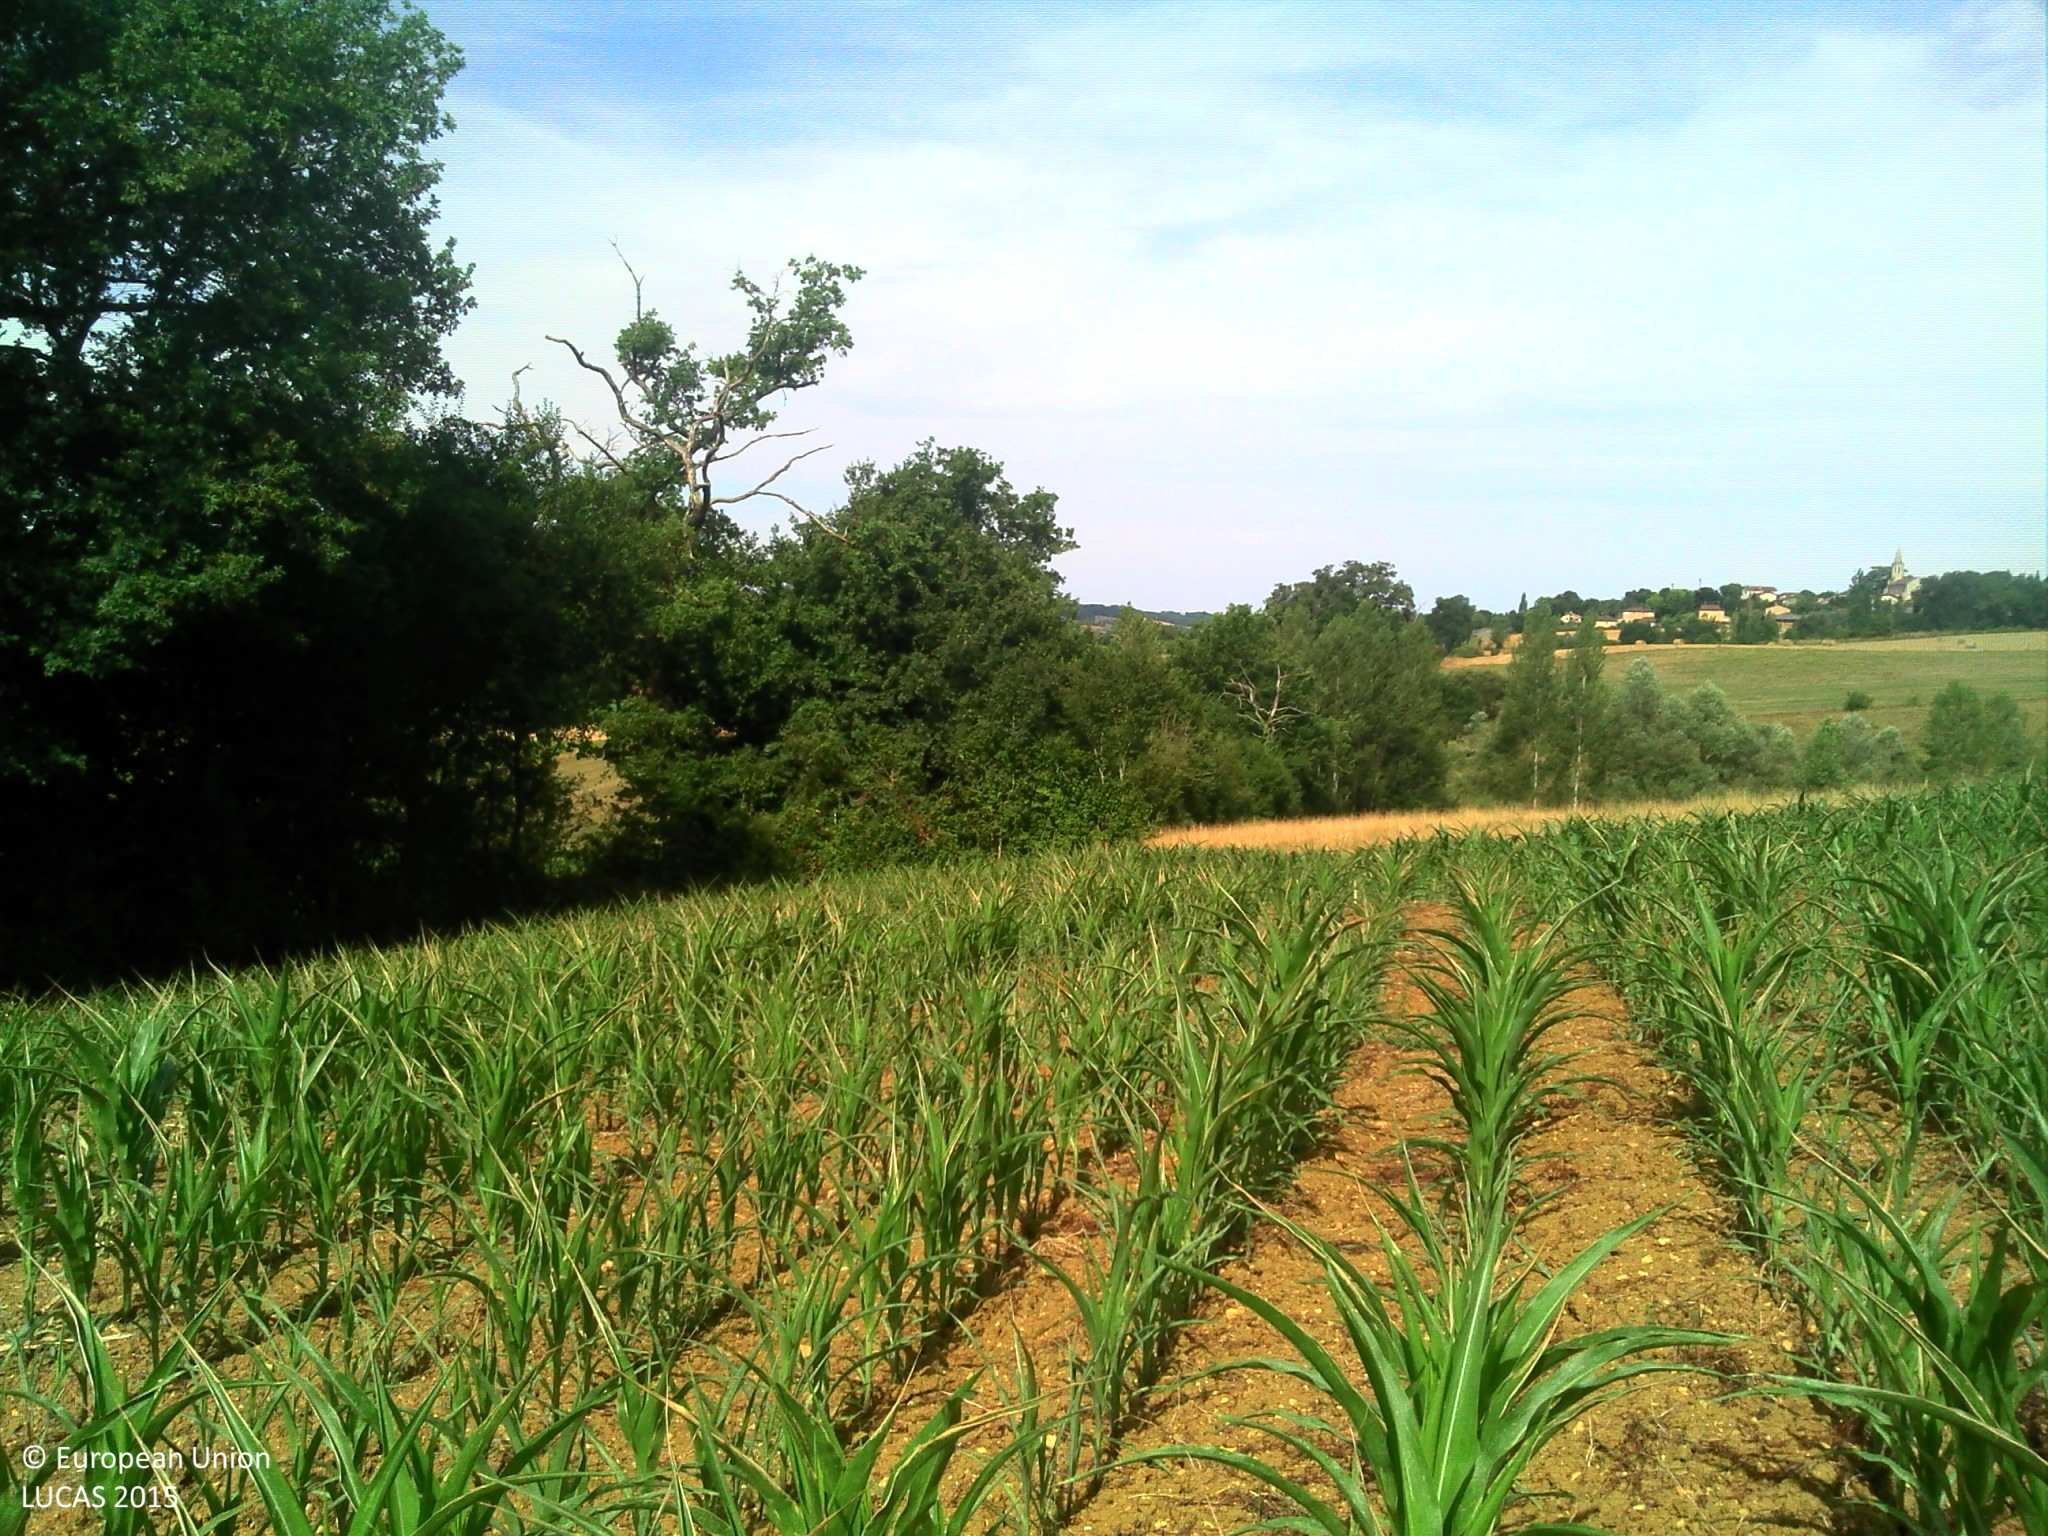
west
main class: Cropland
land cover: Maize
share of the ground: > 75 %
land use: Agriculture (excluding fallow land and kitchen gardens)
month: July
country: FR
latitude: 43.1306
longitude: 0.8690
